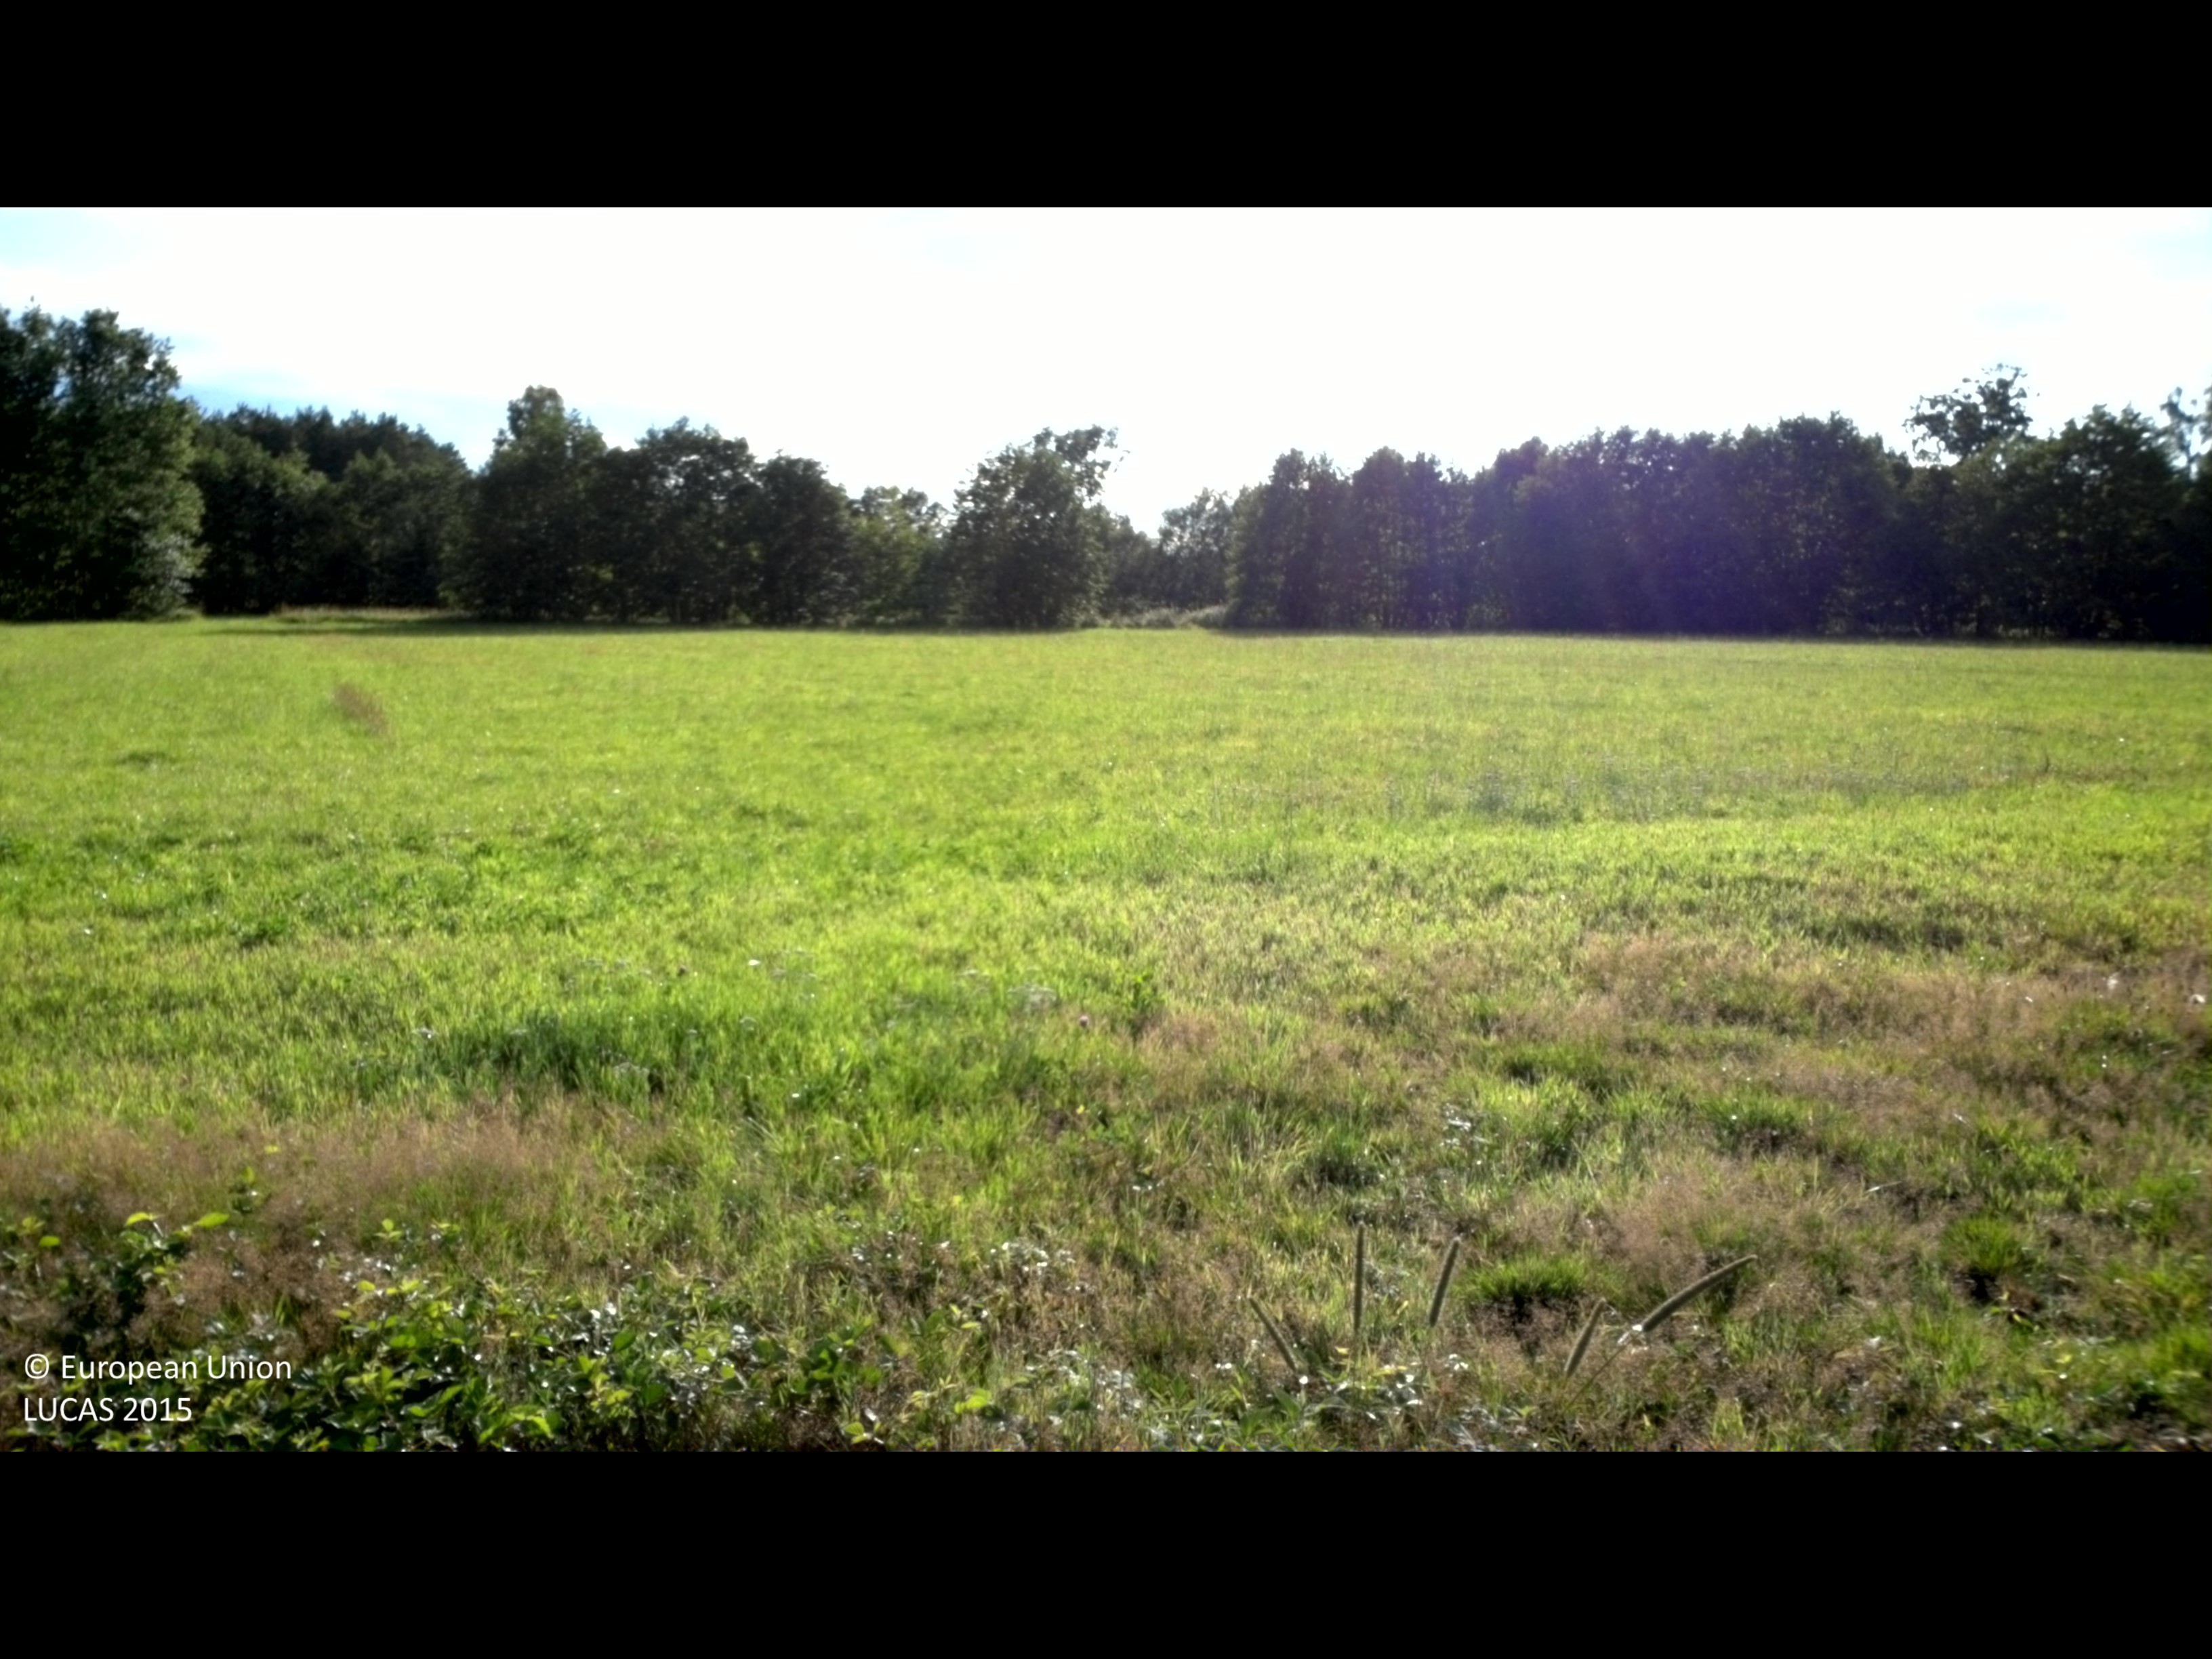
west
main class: Shrubland
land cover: Shrubland without tree cover
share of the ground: > 75 %
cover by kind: shrubs 85 %, herbaceous plants 15 %
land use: Semi-natural and natural areas not in use
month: July
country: SE
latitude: 57.1524
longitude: 16.9943
